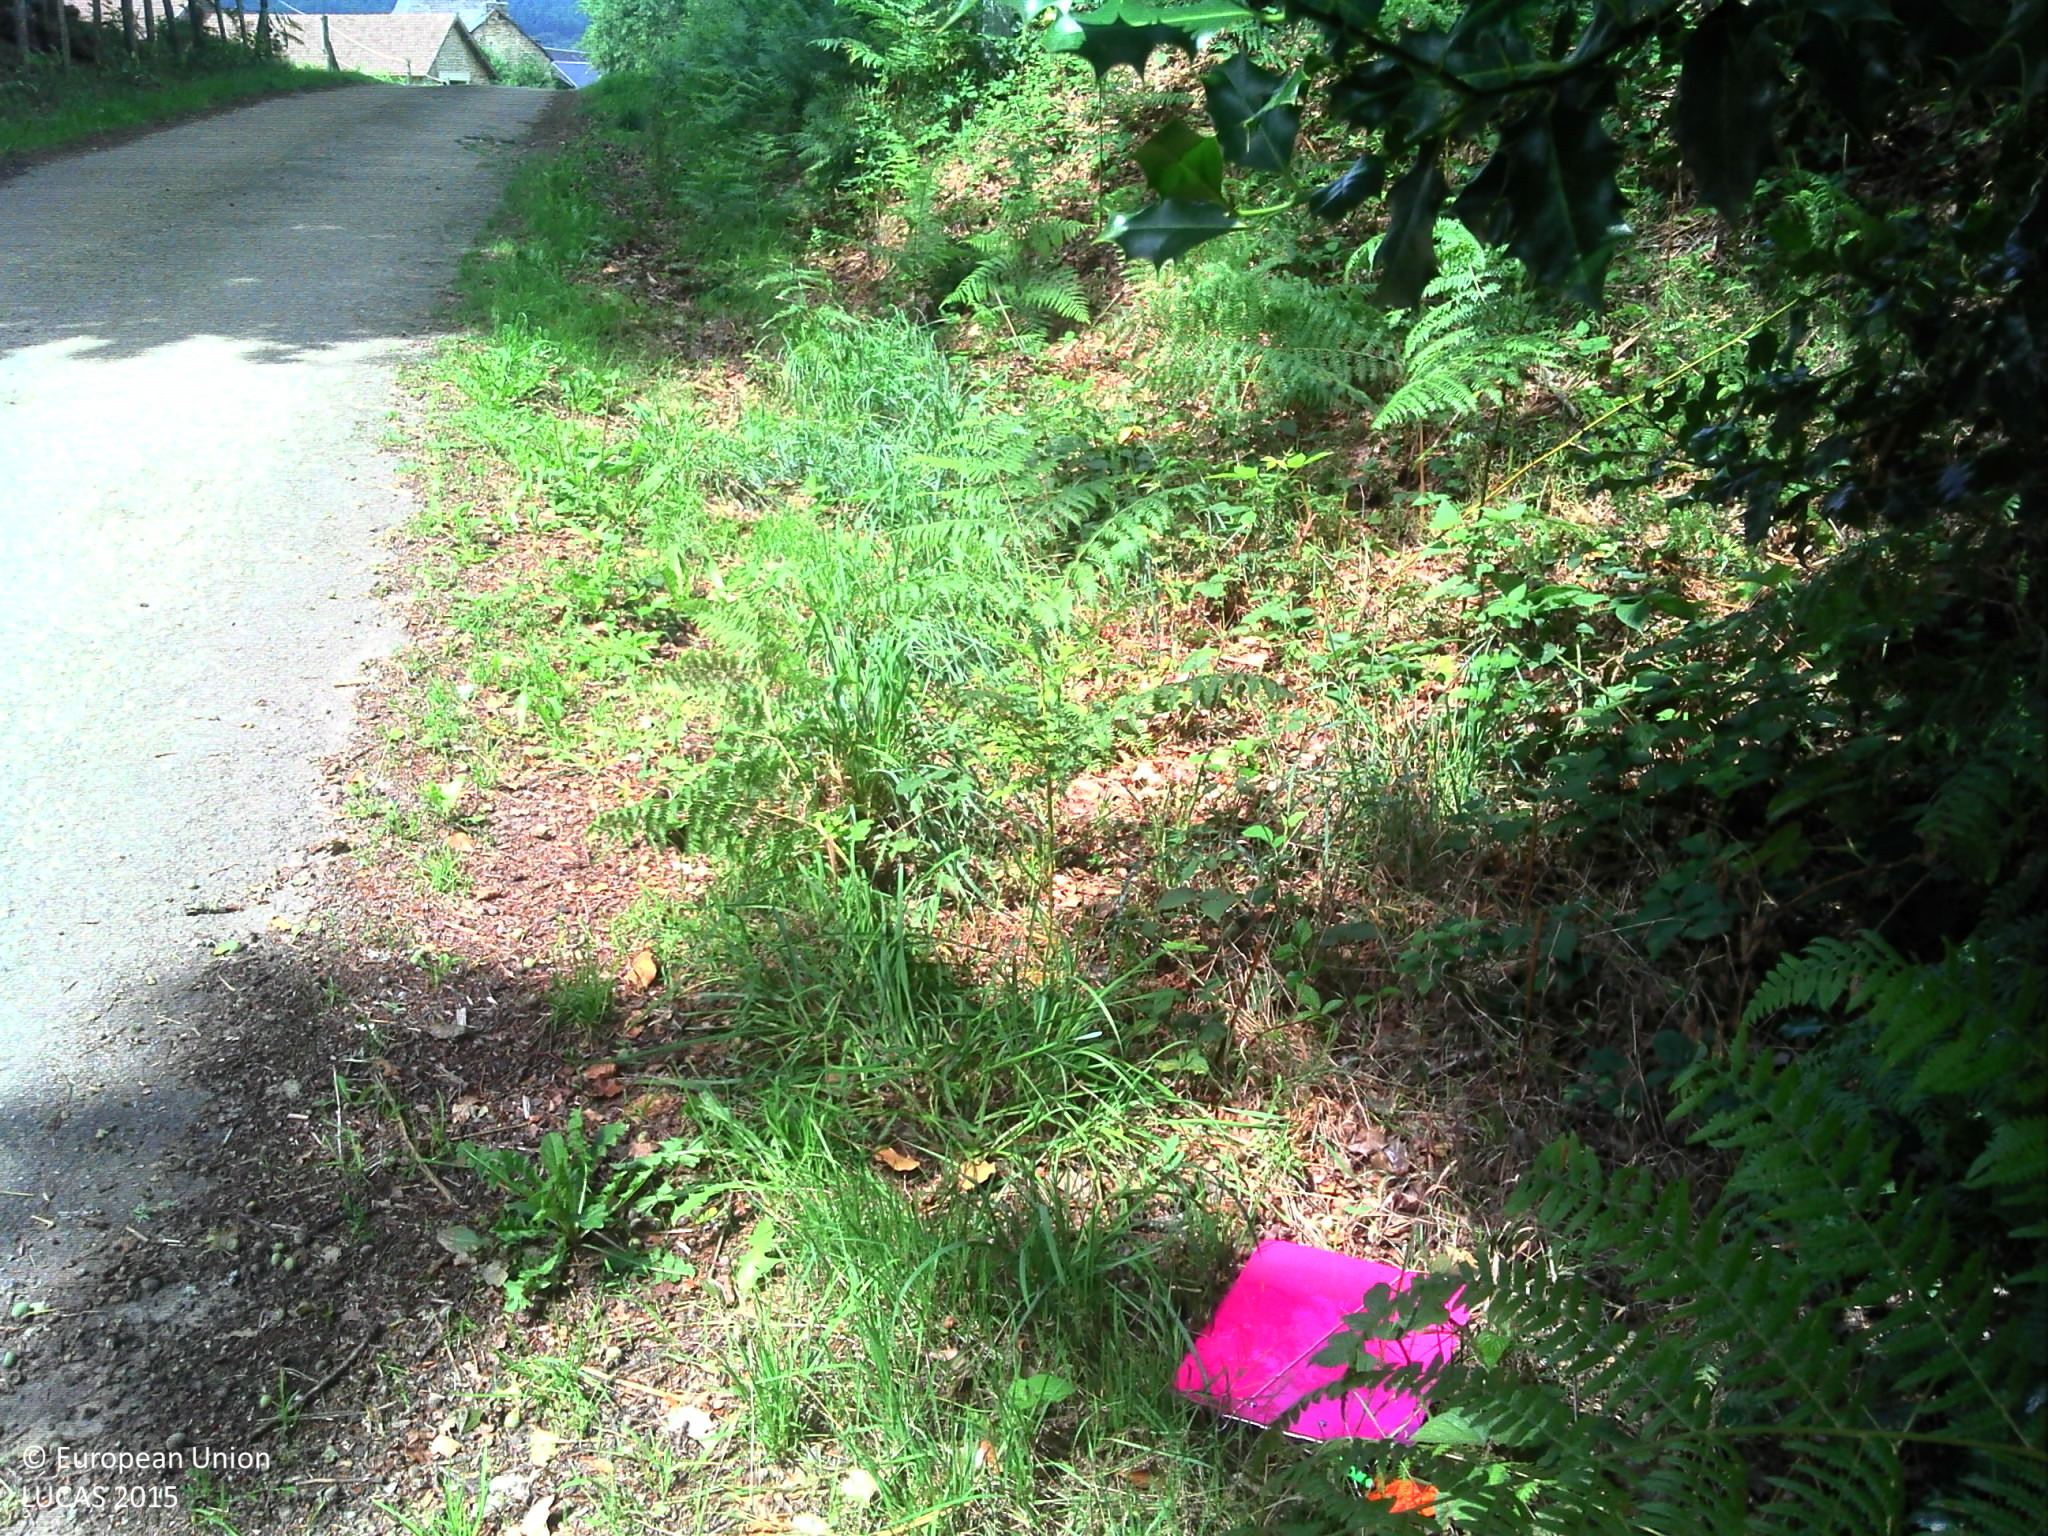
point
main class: Grassland
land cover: Spontaneously vegetated surfaces
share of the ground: > 75 %
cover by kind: herbaceous plants 95 %, shrubs 5 %
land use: Semi-natural and natural areas not in use
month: August
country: FR
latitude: 45.8323
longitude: 1.7417
